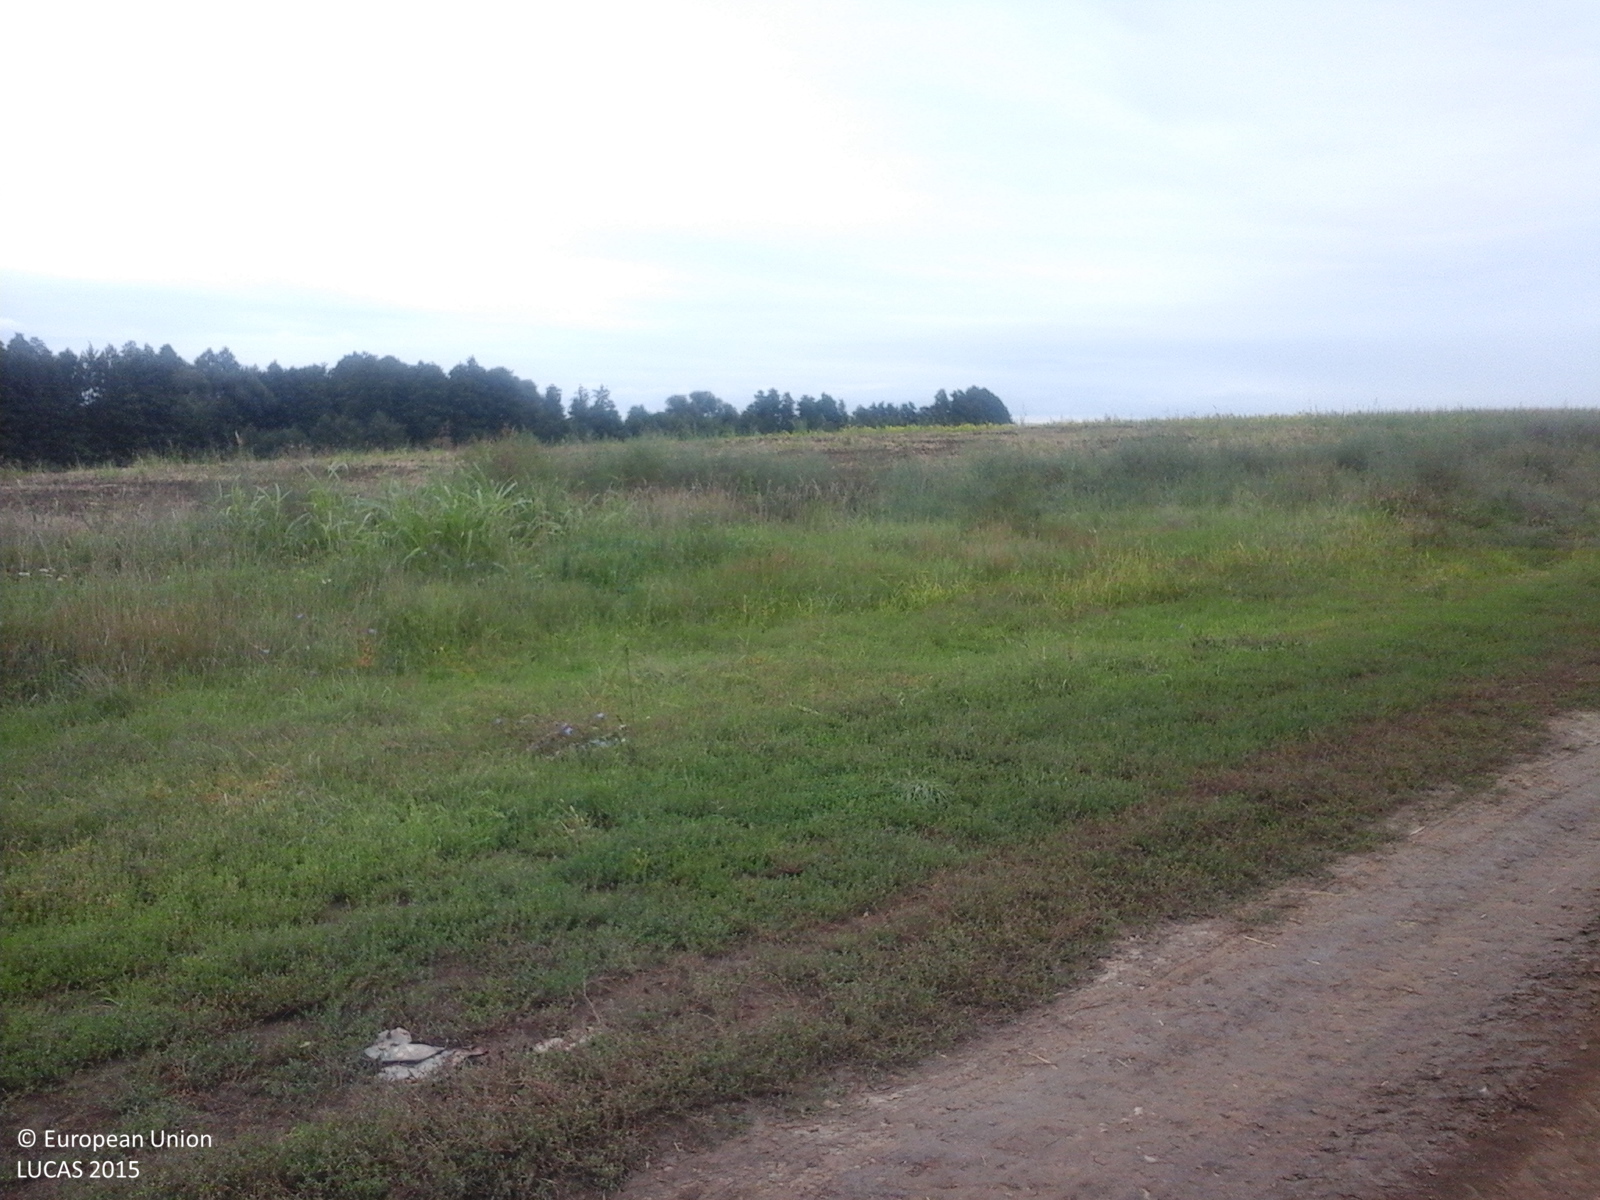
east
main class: Cropland
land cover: Maize
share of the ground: > 75 %
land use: Agriculture (excluding fallow land and kitchen gardens)
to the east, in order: Maize; Grass margins; Tracks; Spontaneously vegetated surfaces; Ditches and canals; Spontaneously vegetated surfaces; Common wheat; Sunflower; Lucerne; Inland marshes; Other bare soil
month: September
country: RO
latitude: 47.3349
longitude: 21.9453
